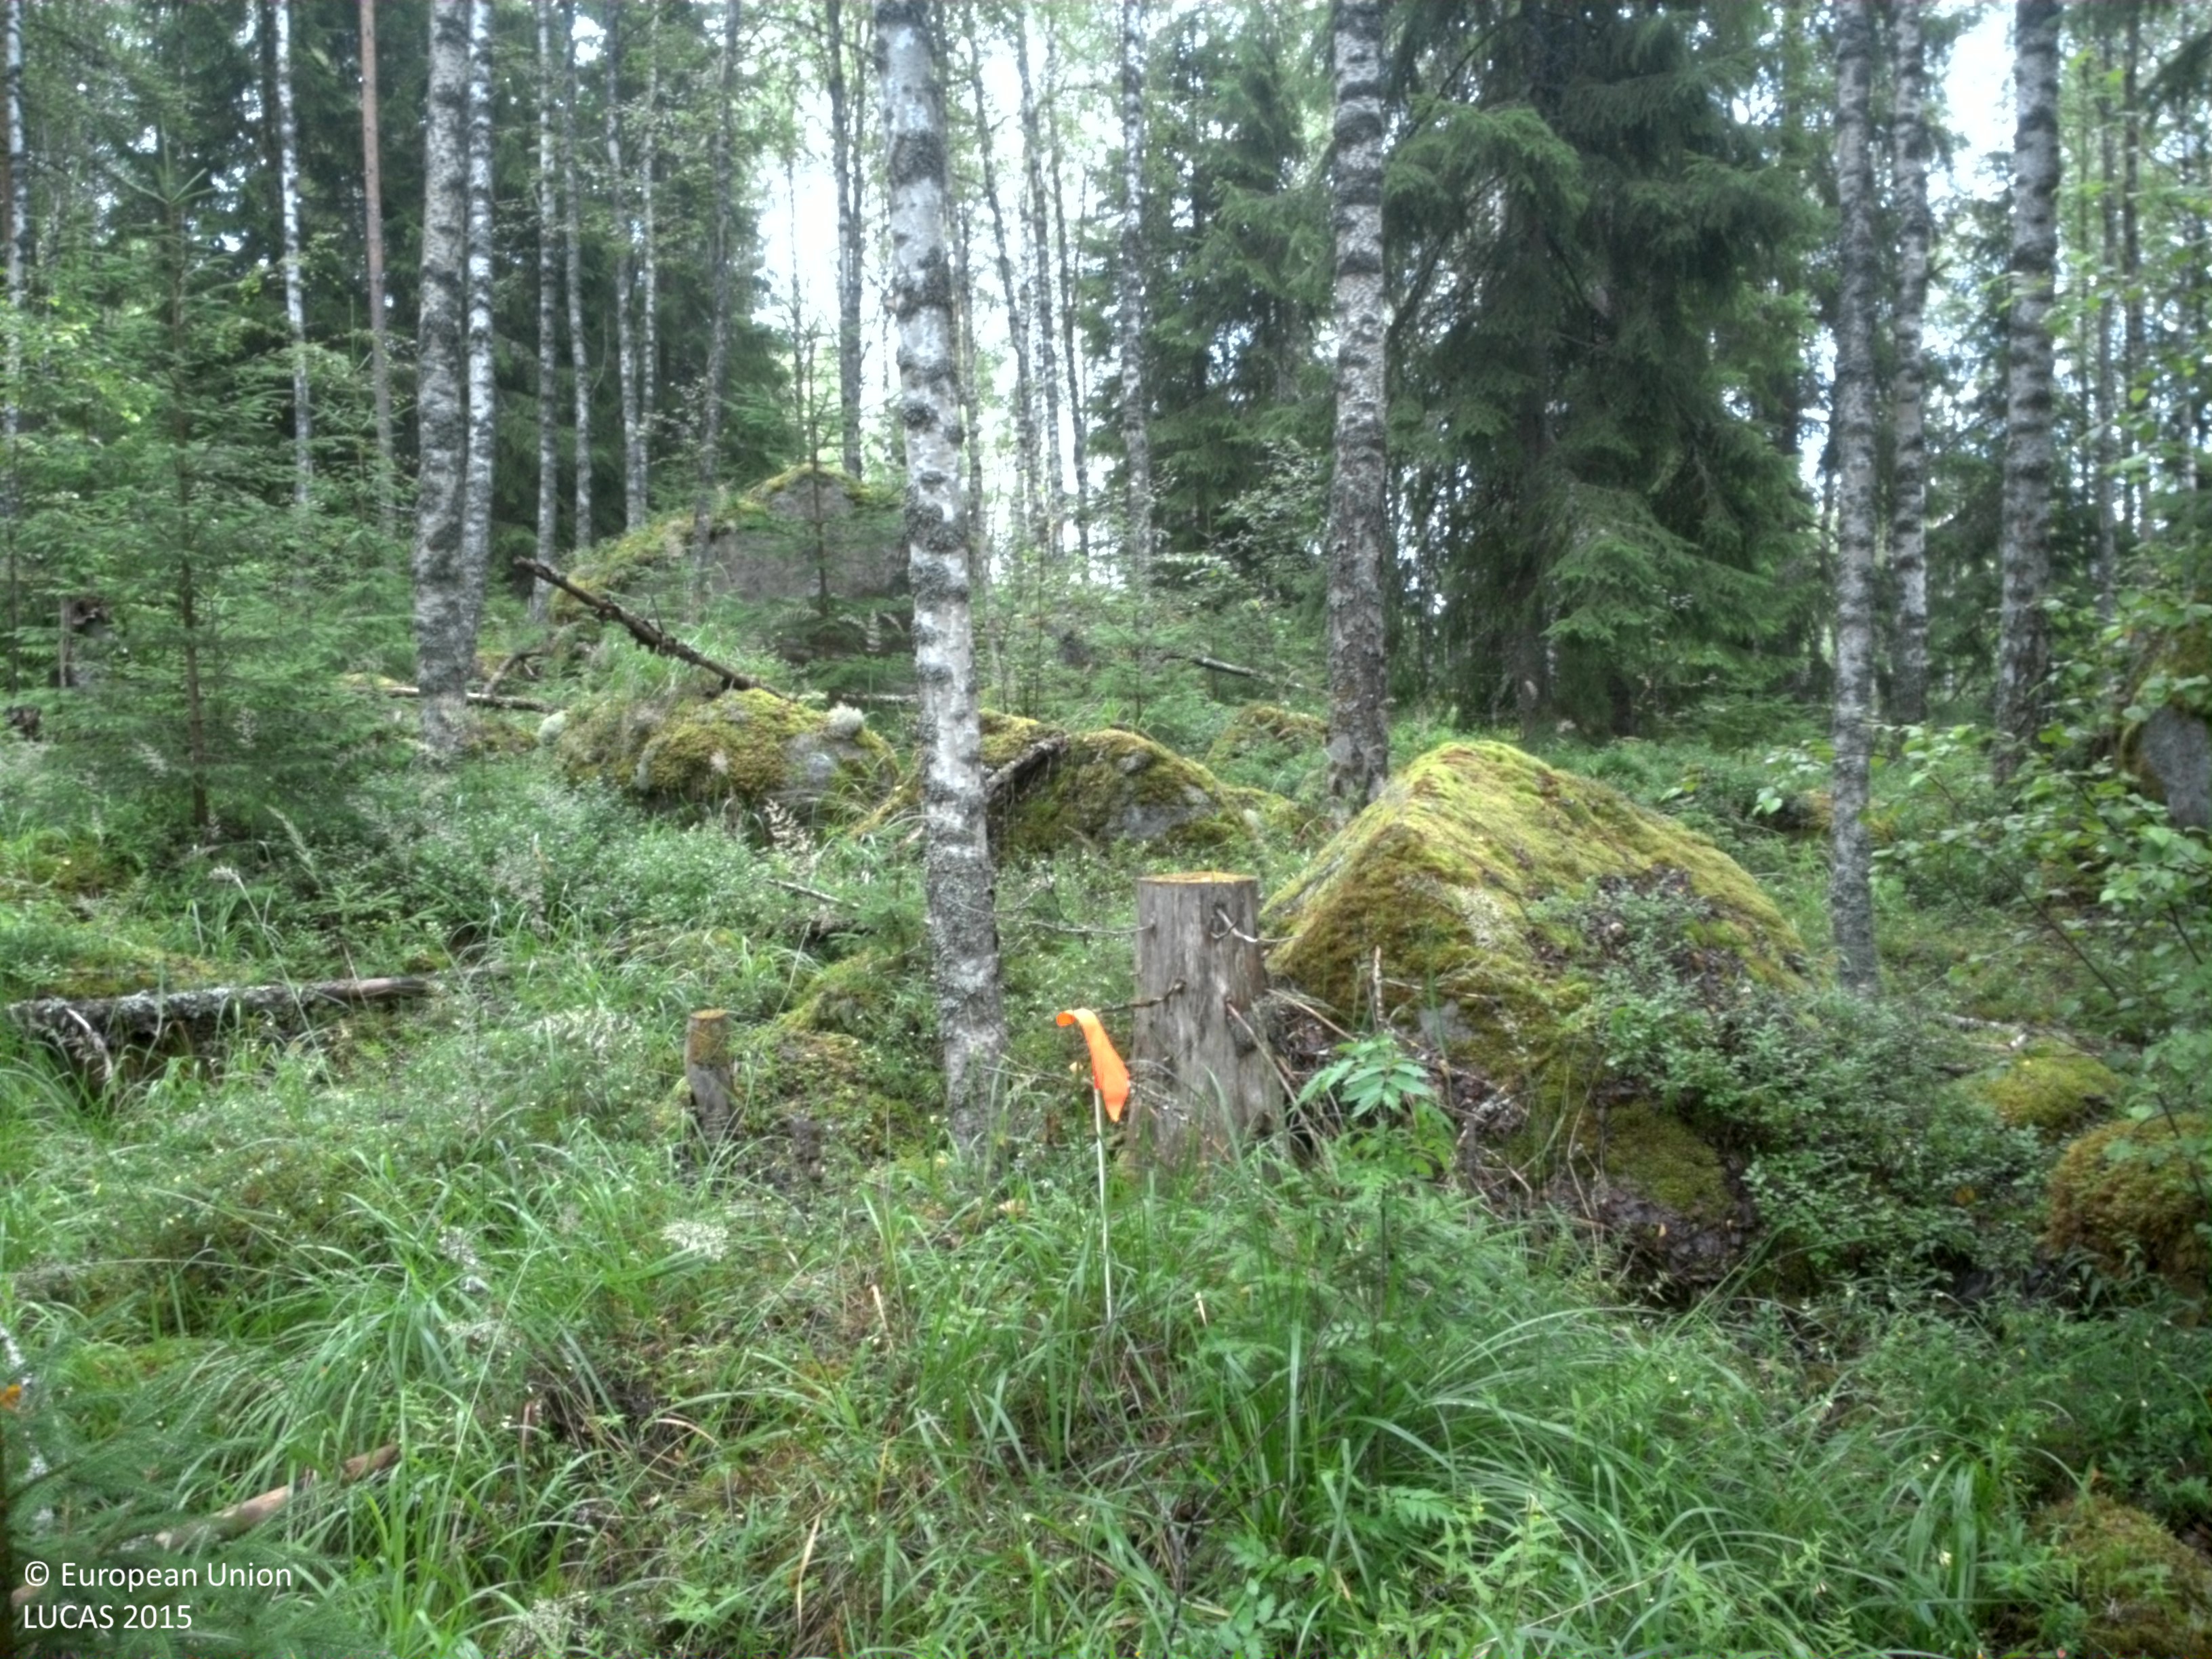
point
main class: Woodland
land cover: Other mixed woodland
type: boreal forest
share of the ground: > 75 %
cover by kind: broadleaved forest trees 45 %, coniferous forest trees 30 %, herbaceous plants 15 %, shrubs 5 %, lichens and mosses 5 %
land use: Forestry
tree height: > 5 m
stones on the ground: > 50 %
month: July
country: SE
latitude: 59.6855
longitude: 14.2002
